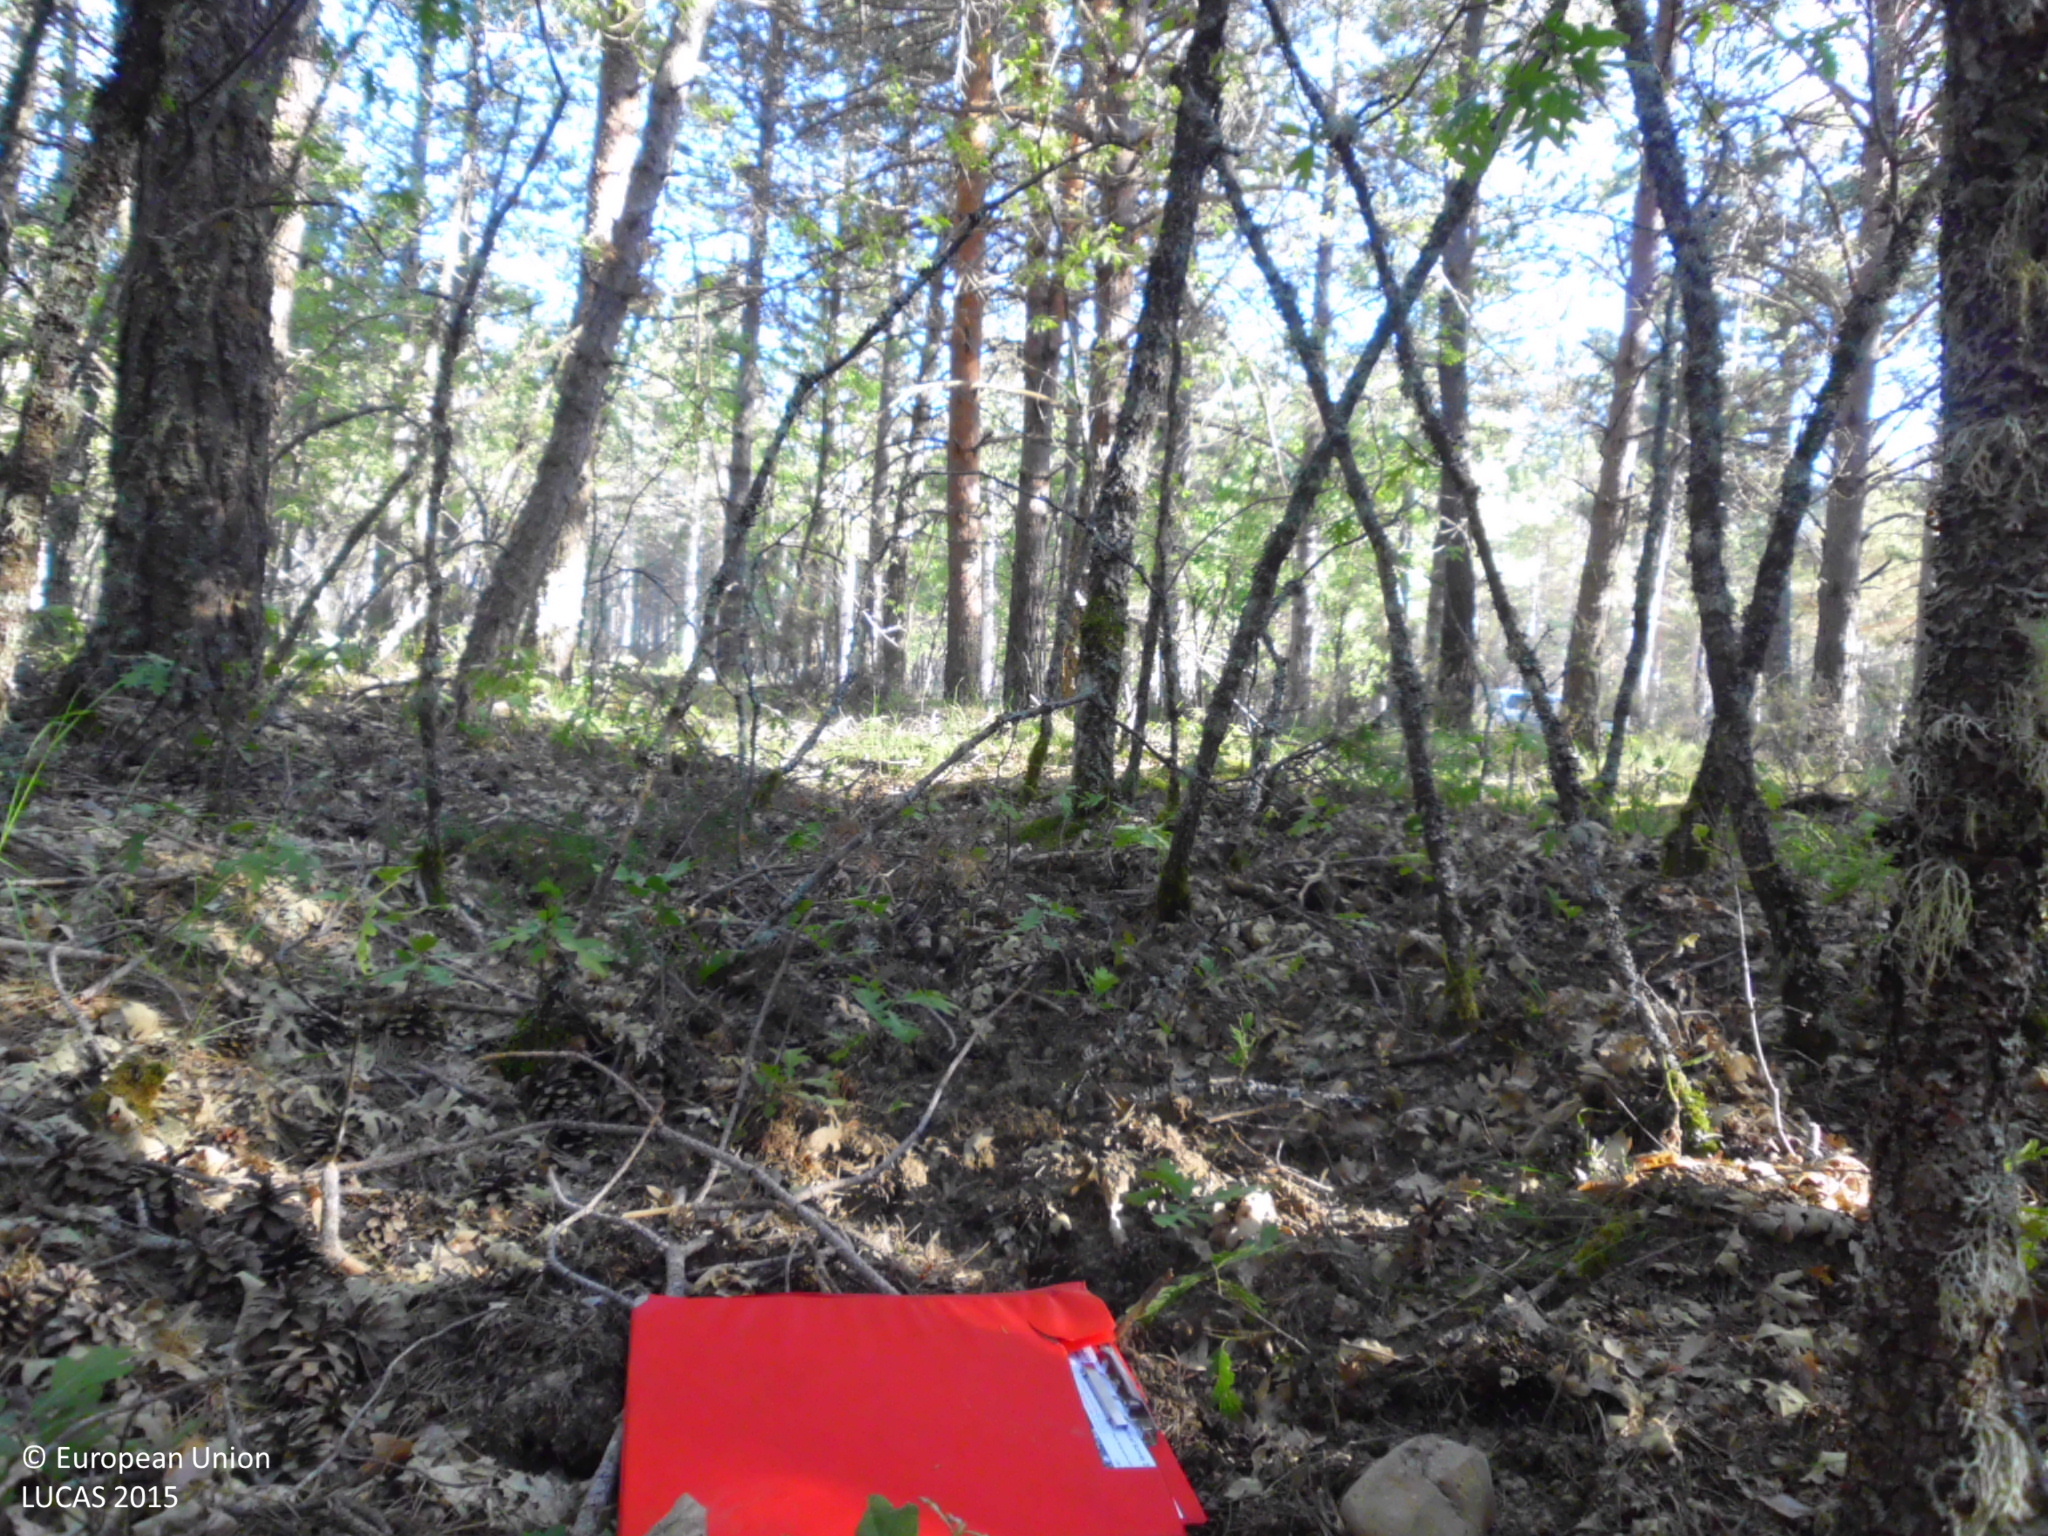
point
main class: Woodland
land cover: Pine dominated coniferous woodland
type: coniferous forest of the mediterranean region
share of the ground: > 75 %
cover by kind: coniferous forest trees 100 %
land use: Forestry
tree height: > 5 m
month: May
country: ES
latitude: 42.6866
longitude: -4.8643
